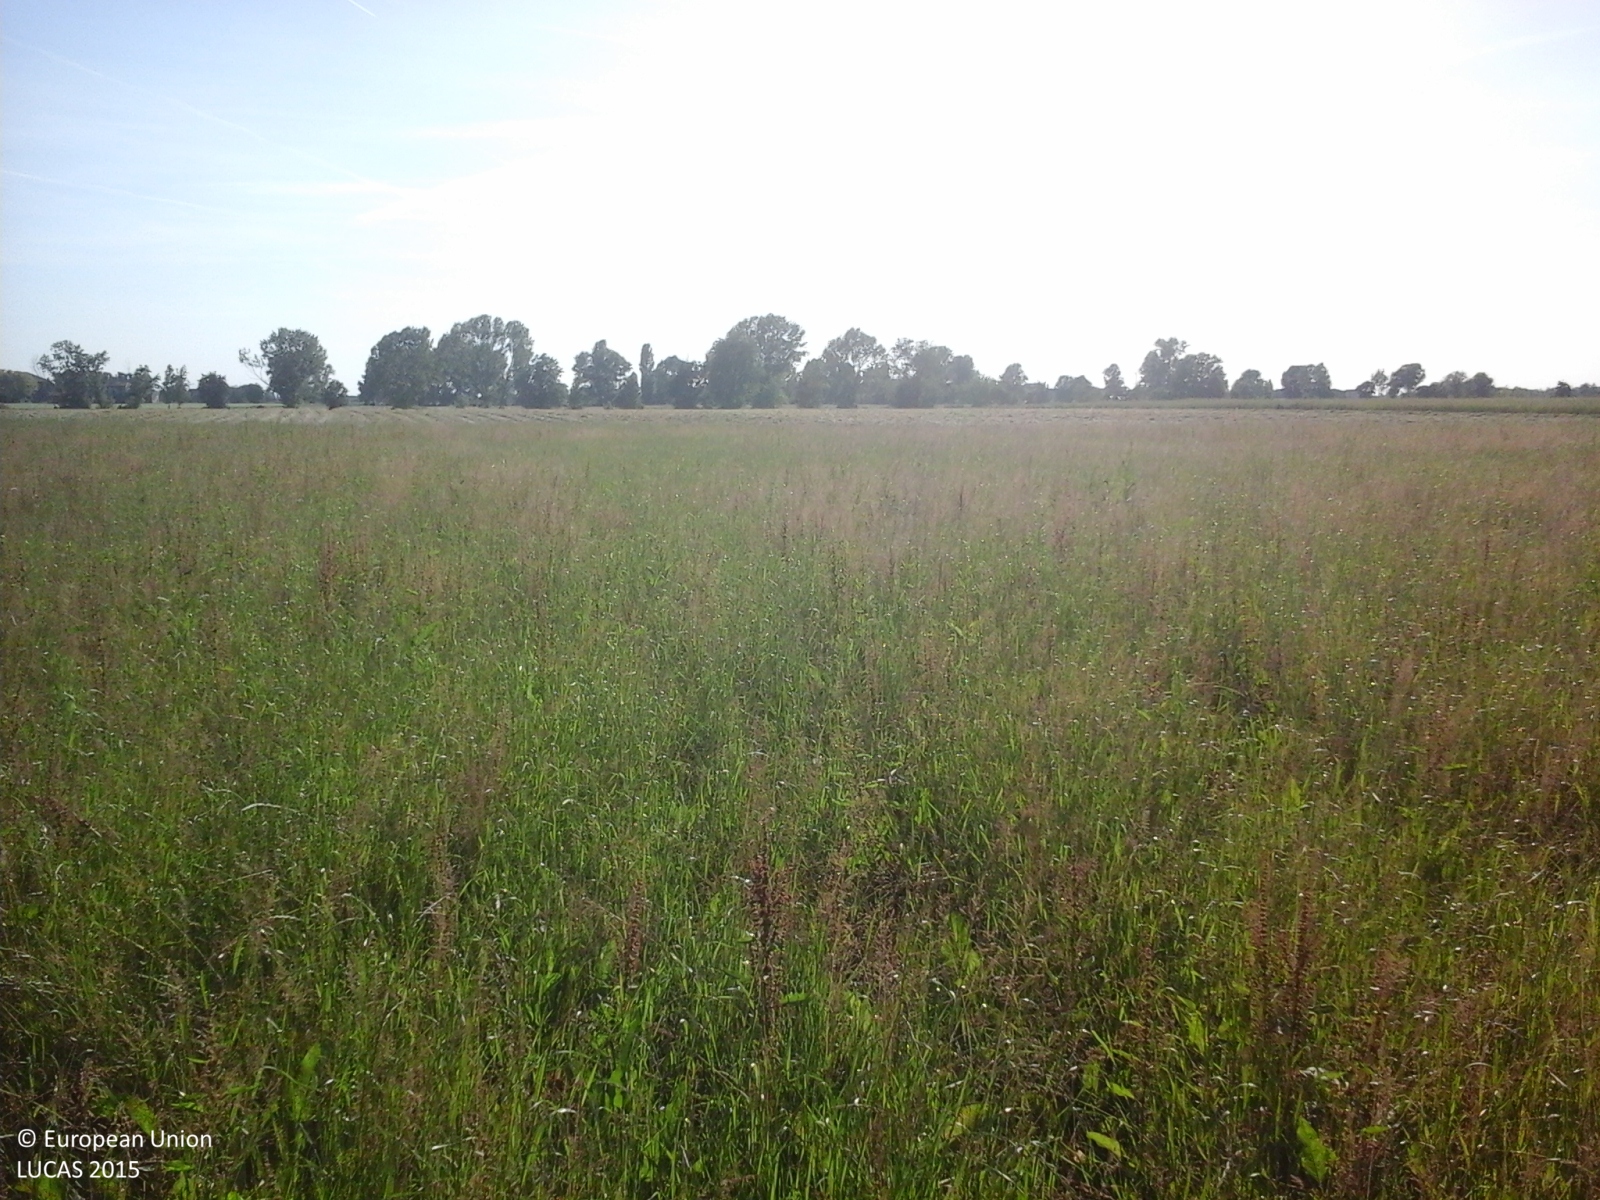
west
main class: Cropland
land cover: Temporary grasslands
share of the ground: > 75 %
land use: Agriculture (excluding fallow land and kitchen gardens)
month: May
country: IT
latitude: 44.9776
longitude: 10.9239
